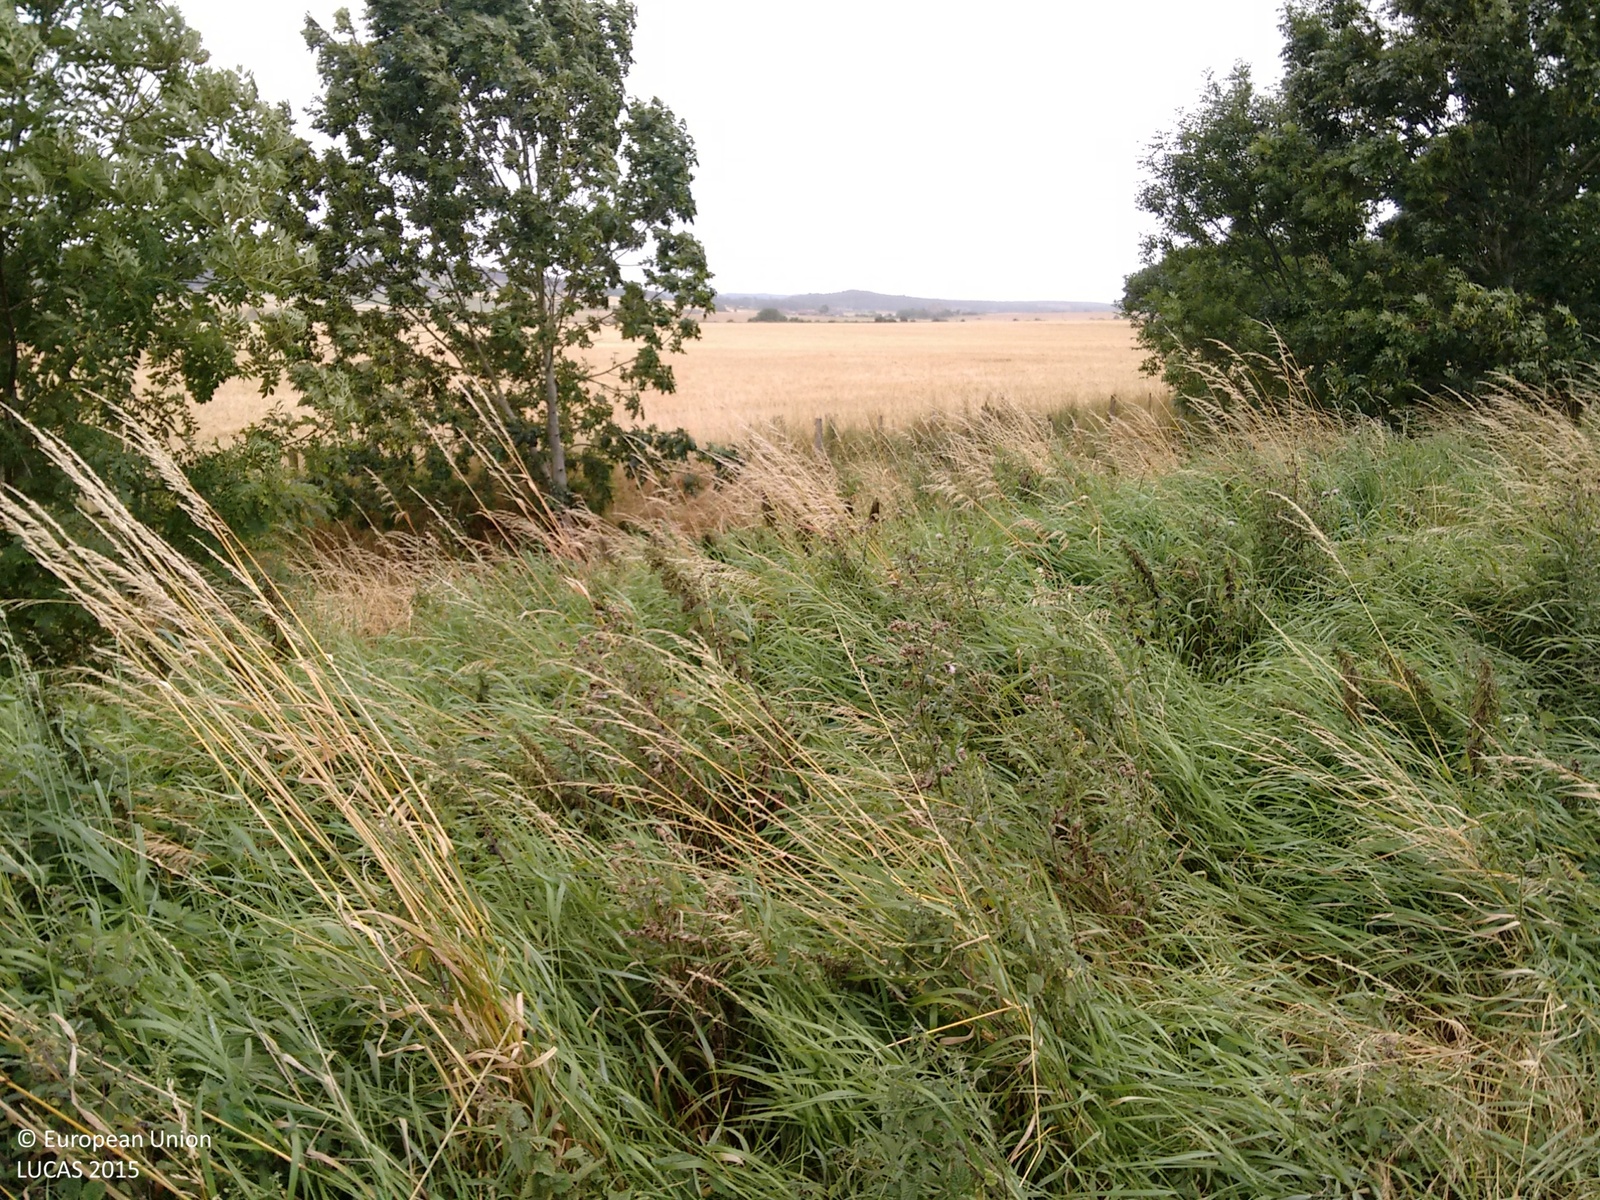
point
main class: Cropland
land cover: Barley
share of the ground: > 75 %
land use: Agriculture (excluding fallow land and kitchen gardens)
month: September
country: GB
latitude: 57.6759
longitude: -3.3639
